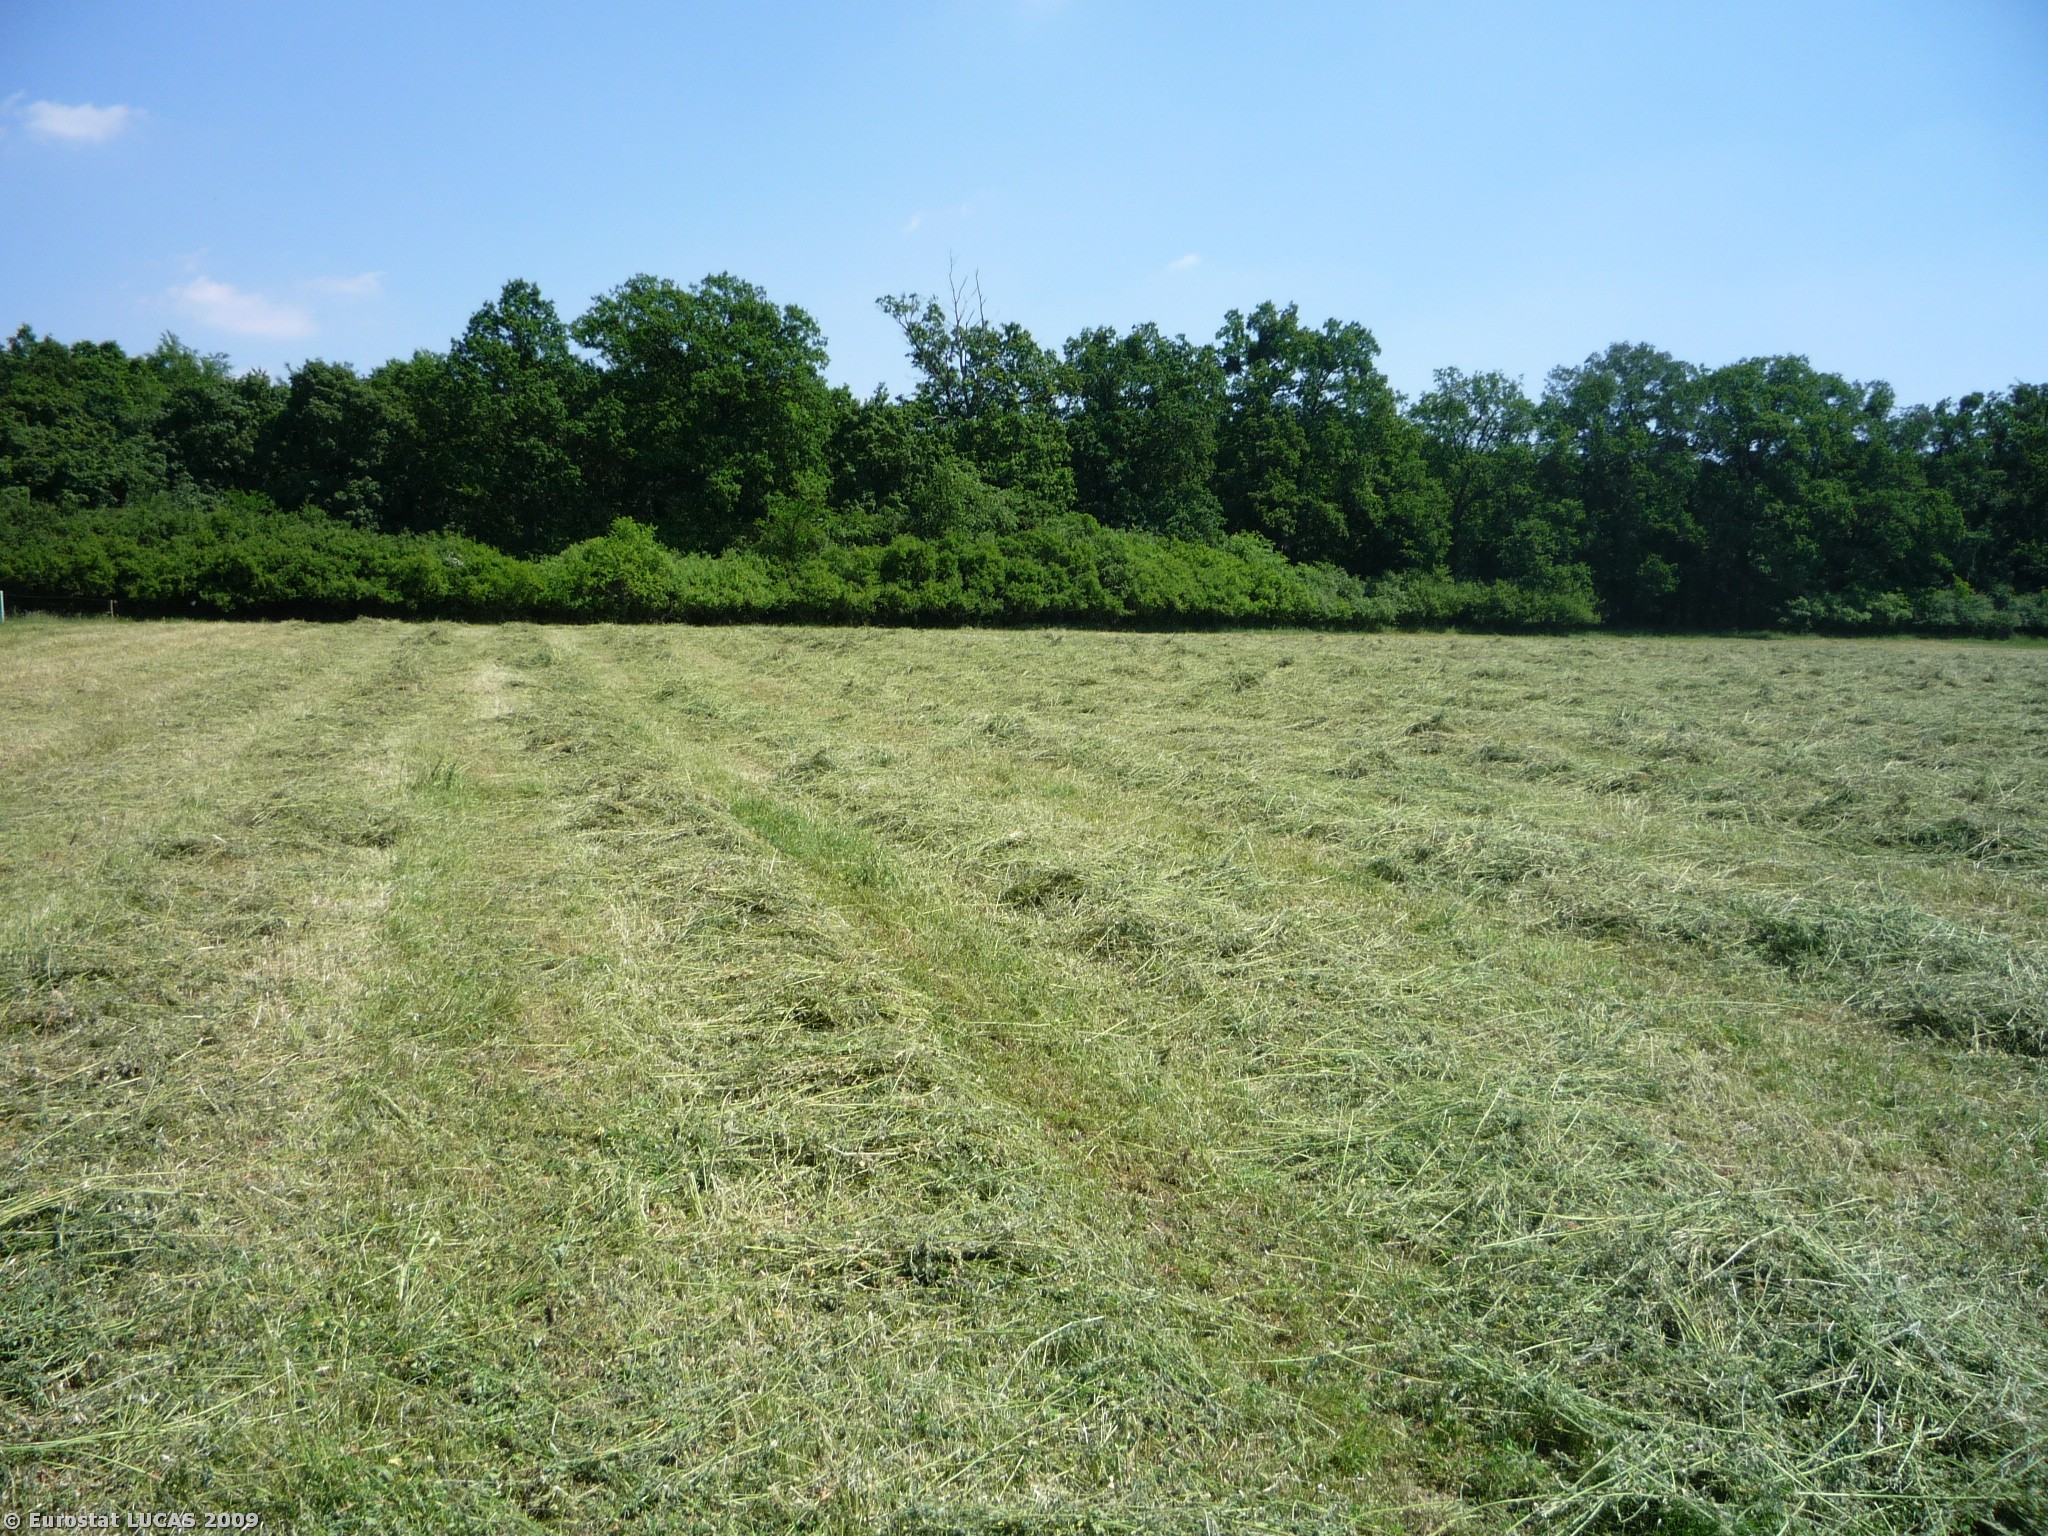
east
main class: Cropland
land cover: Lucerne
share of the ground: > 75 %
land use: Agriculture (excluding fallow land and kitchen gardens)
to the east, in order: Lucerne; Broadleaved woodland
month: May
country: CZ
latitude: 50.2670
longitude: 15.5176
